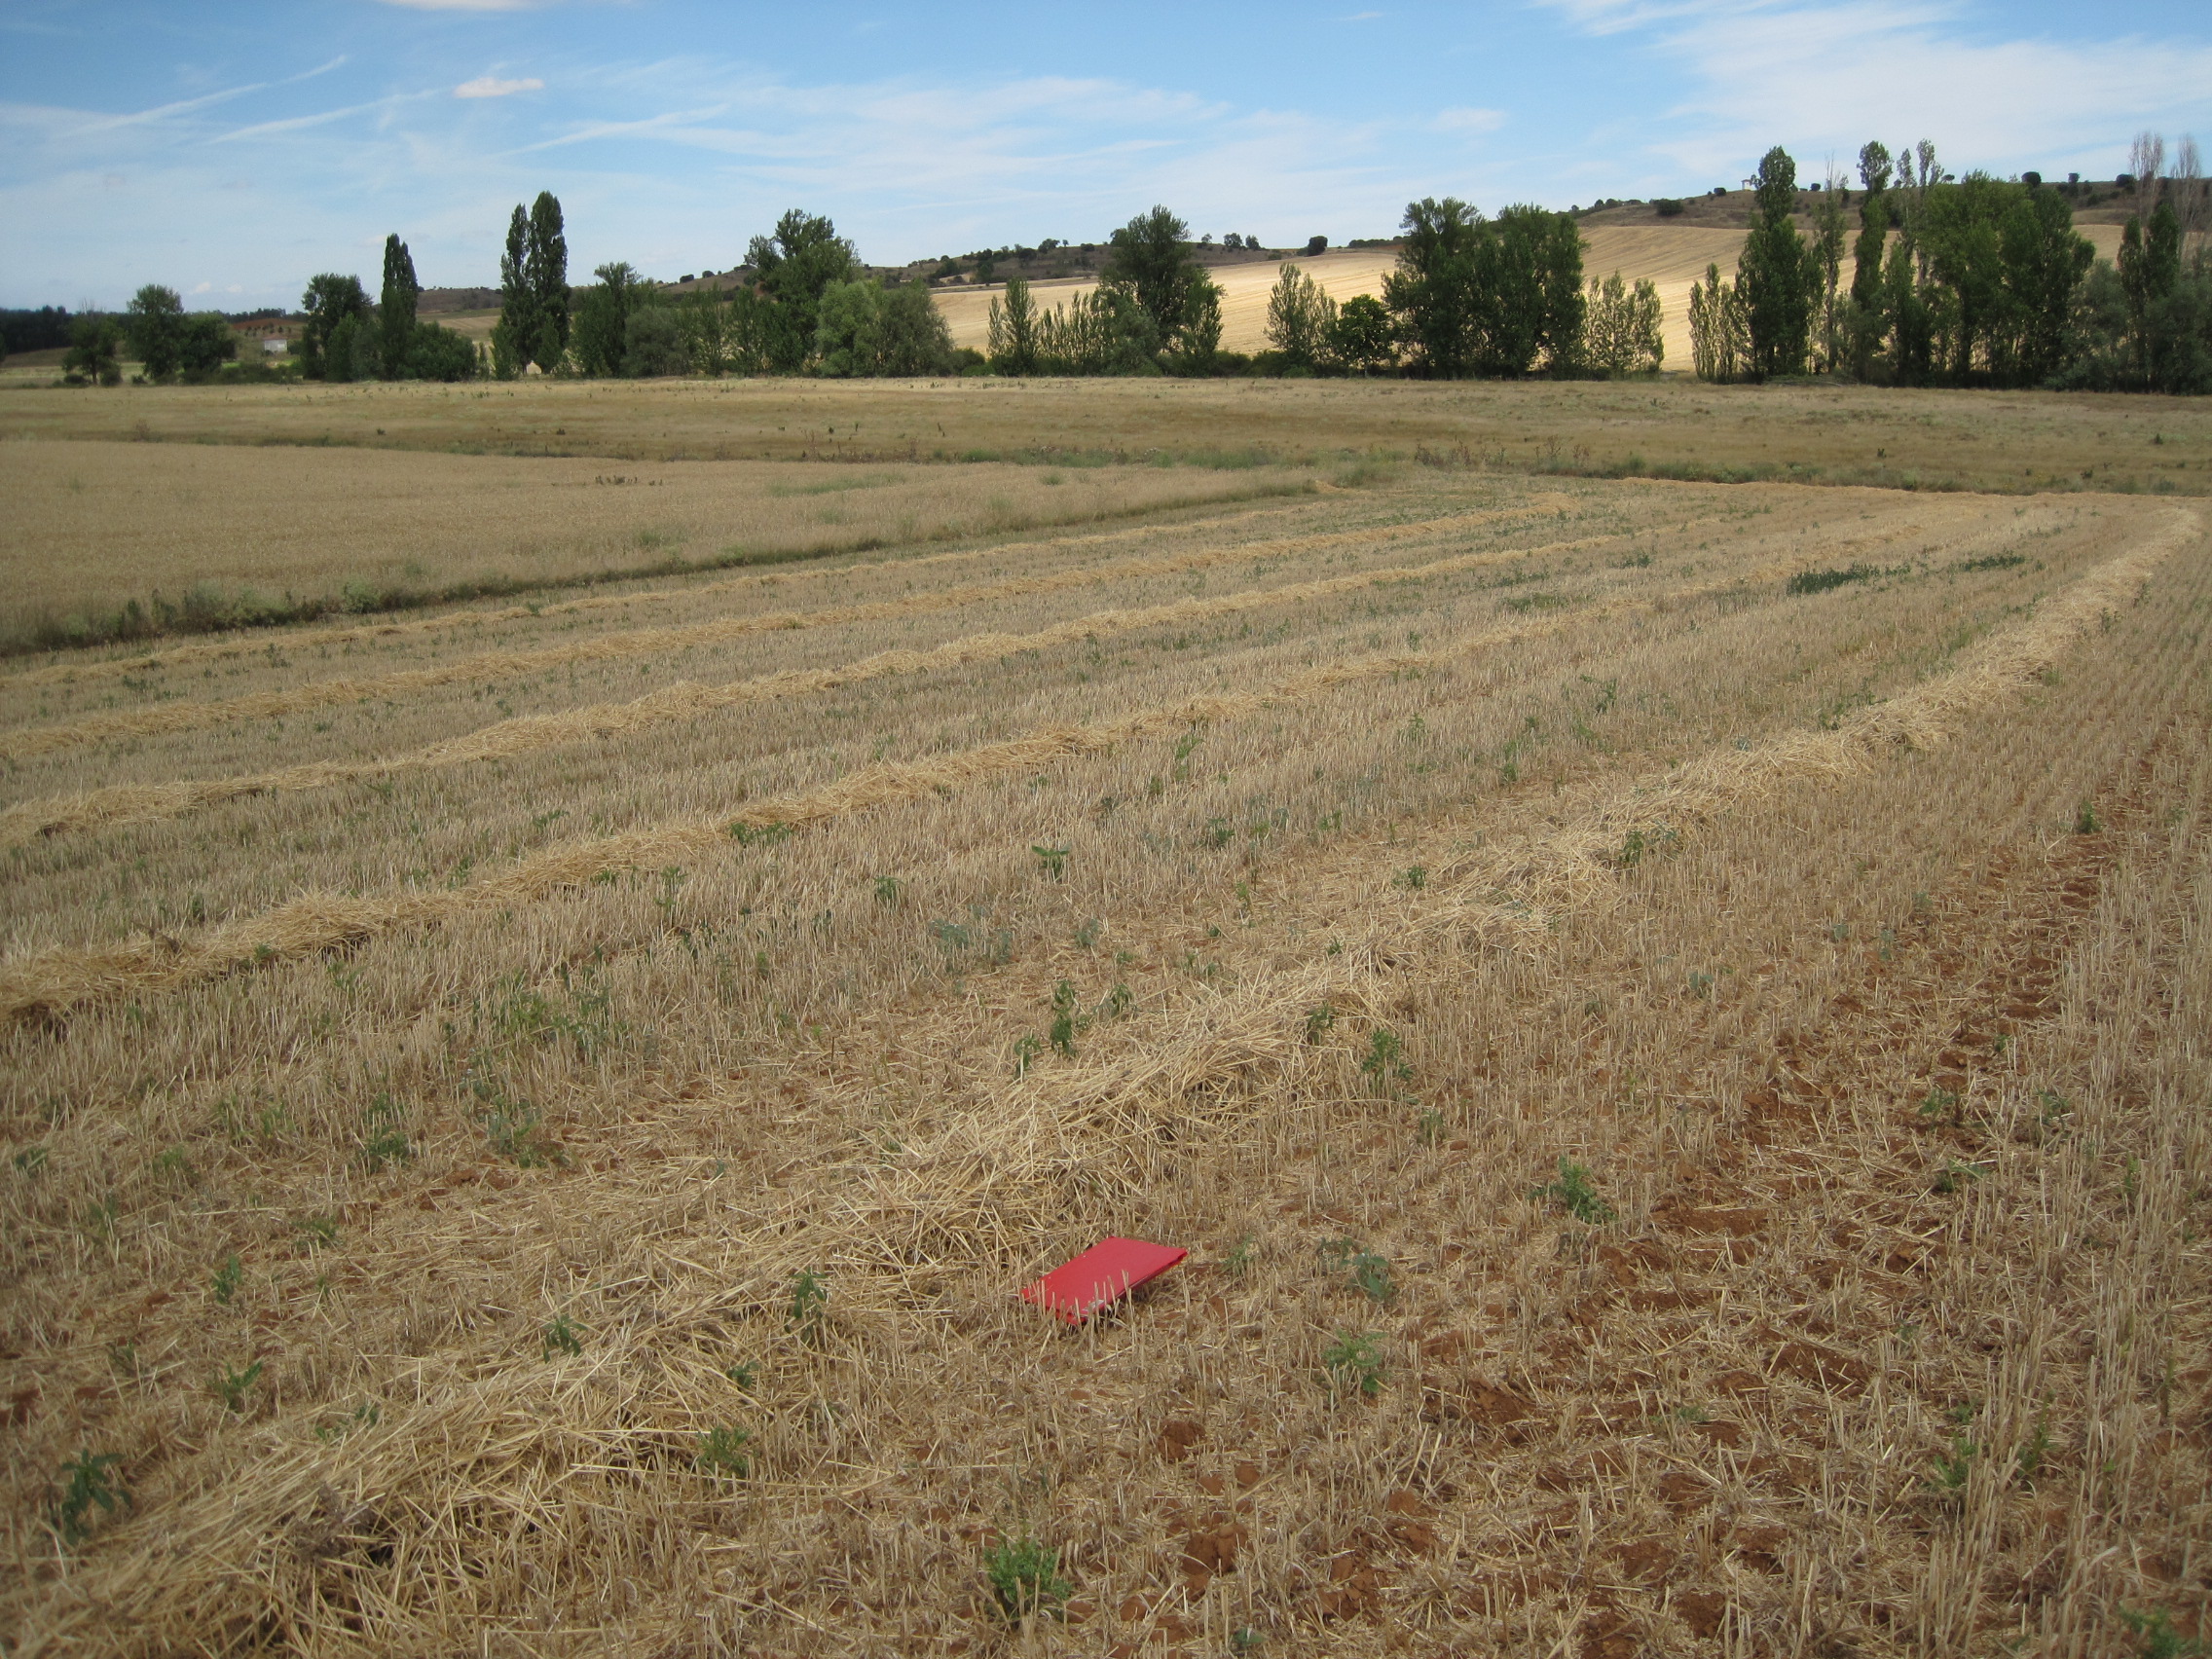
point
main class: Cropland
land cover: Common wheat
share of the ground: < 10 %
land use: Agriculture (excluding fallow land and kitchen gardens)
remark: Harvested field
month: July
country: ES
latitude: 42.1331
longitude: -5.4904
